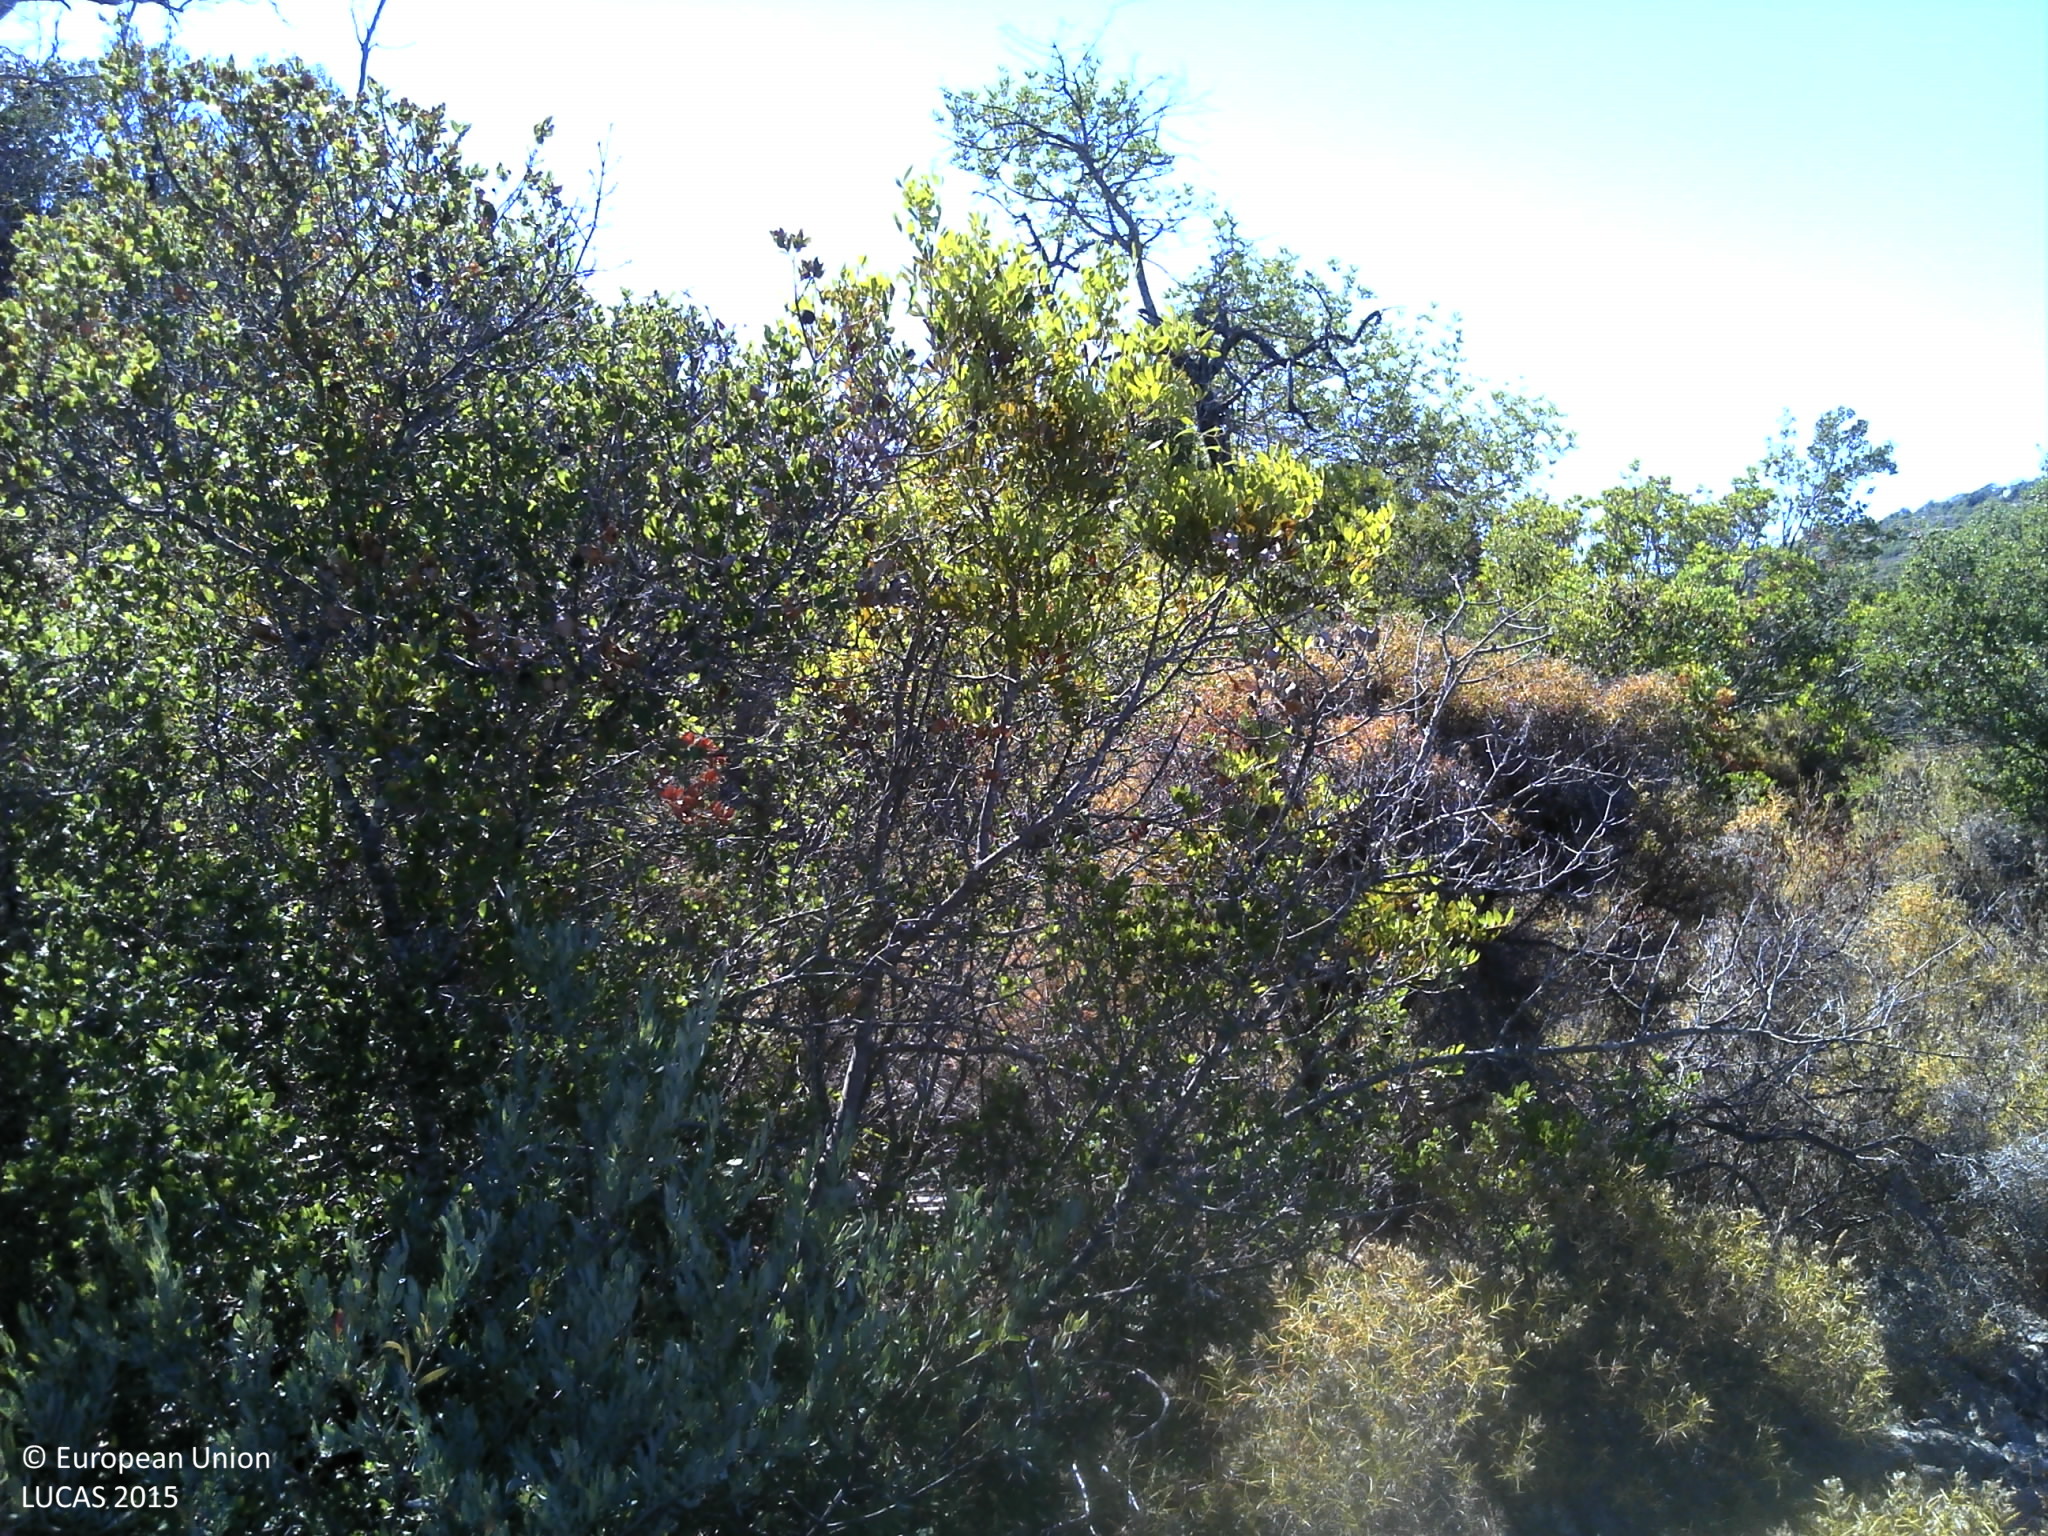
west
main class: Shrubland
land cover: Shrubland with sparse tree cover
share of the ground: 50 - 75 %
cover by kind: shrubs 70 %, unconsolidated bare surface 25 %, broadleaved forest trees 5 %
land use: Abandoned areas
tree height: < 5 m
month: September
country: PT
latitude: 37.1686
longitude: -8.1600
